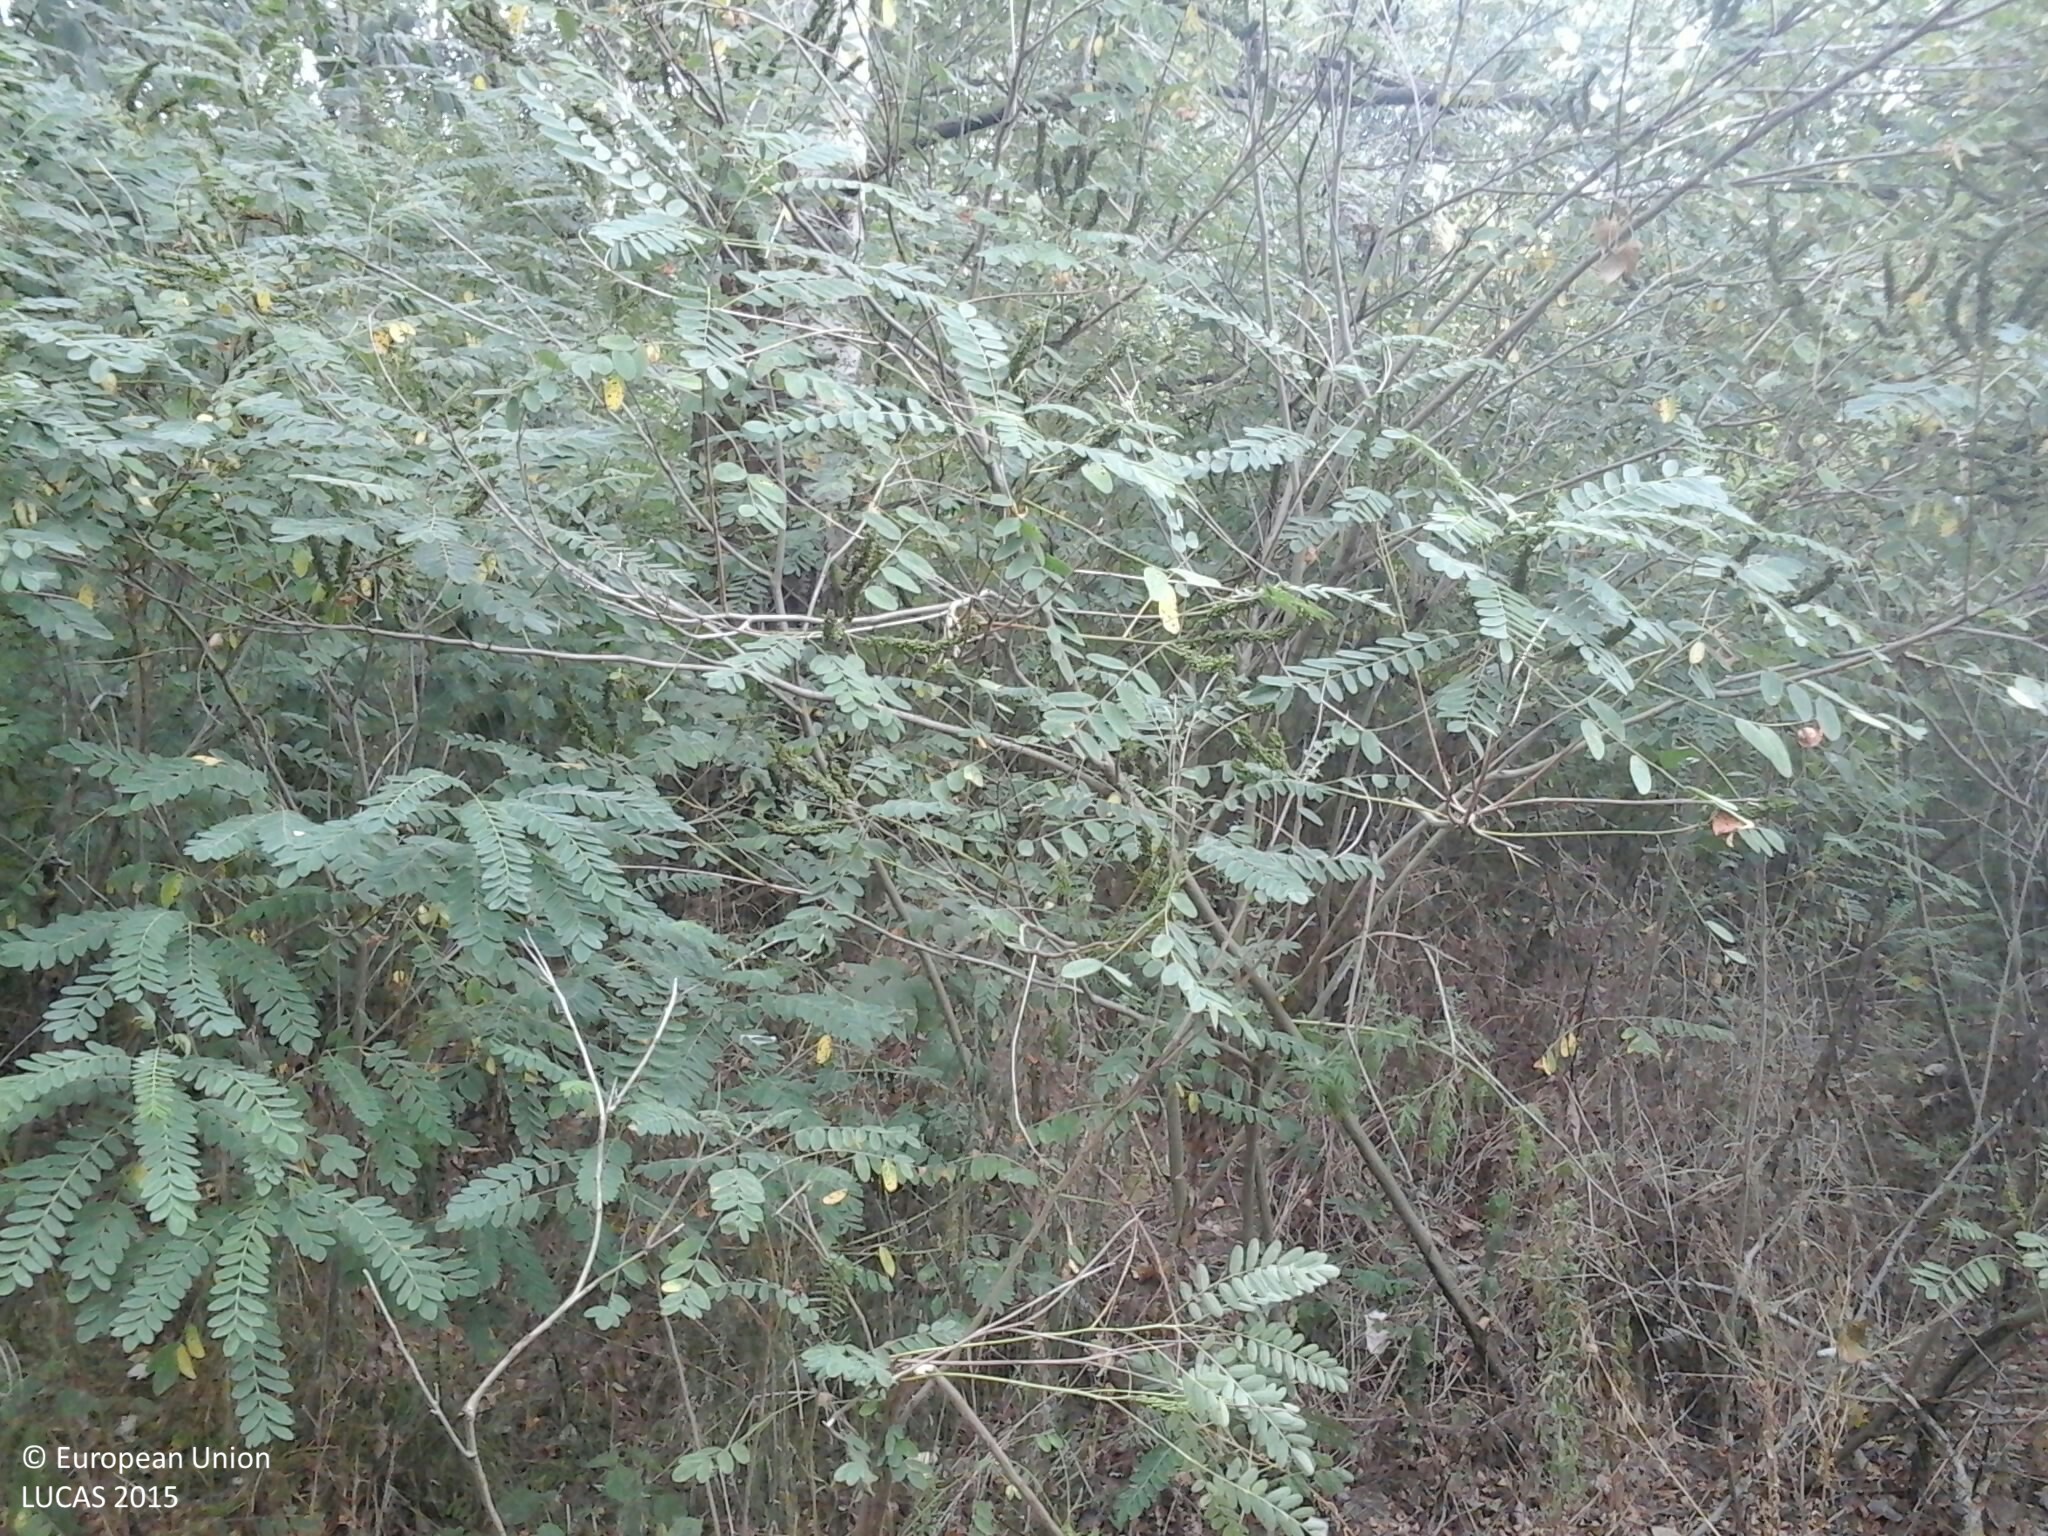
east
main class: Woodland
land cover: Broadleaved woodland
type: floodplain forest
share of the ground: > 75 %
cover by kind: broadleaved forest trees 90 %, shrubs 5 %, herbaceous plants 5 %
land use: Forestry
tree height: < 5 m
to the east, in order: Broadleaved woodland; Tracks; Broadleaved woodland; Tracks; Broadleaved woodland
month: July
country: HU
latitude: 46.9577
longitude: 20.1302
